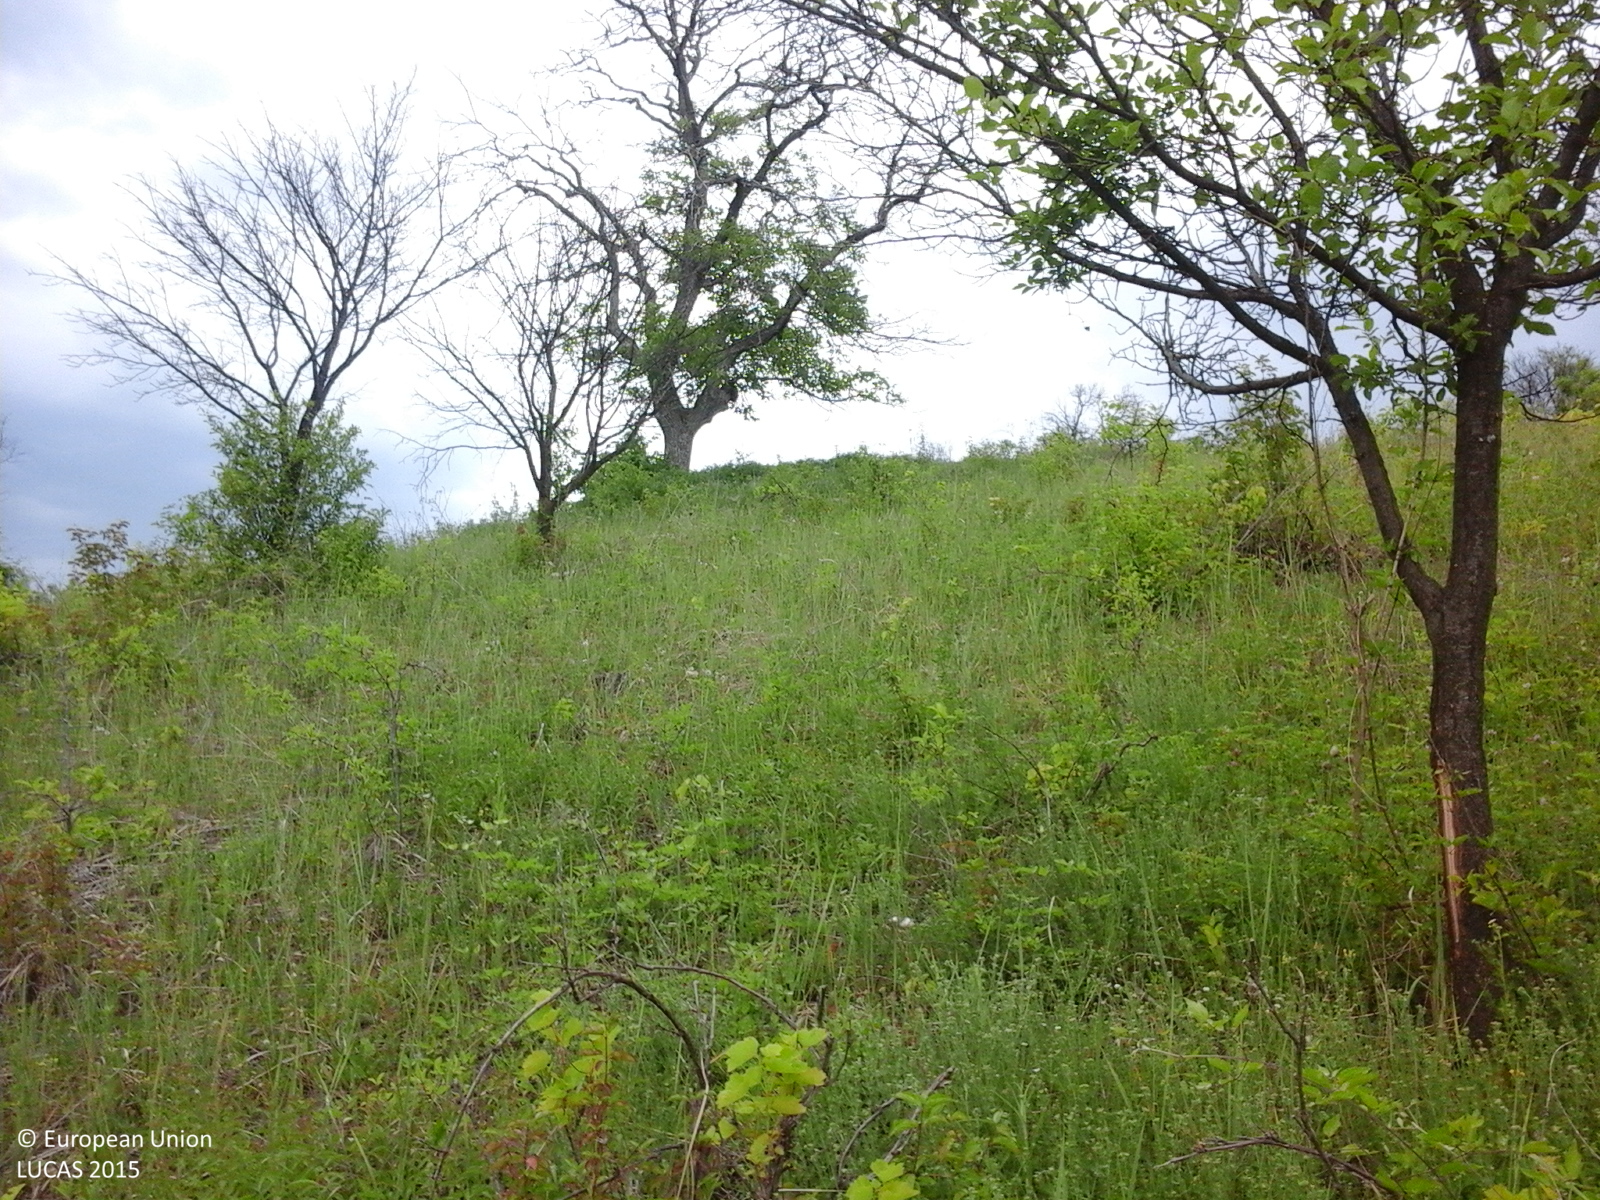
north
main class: Grassland
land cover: Grassland with sparse tree/shrub cover
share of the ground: > 75 %
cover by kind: herbaceous plants 90 %, broadleaved forest trees 5 %, shrubs 5 %
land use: Forestry
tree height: < 5 m
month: June
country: RO
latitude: 46.3540
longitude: 26.7881
